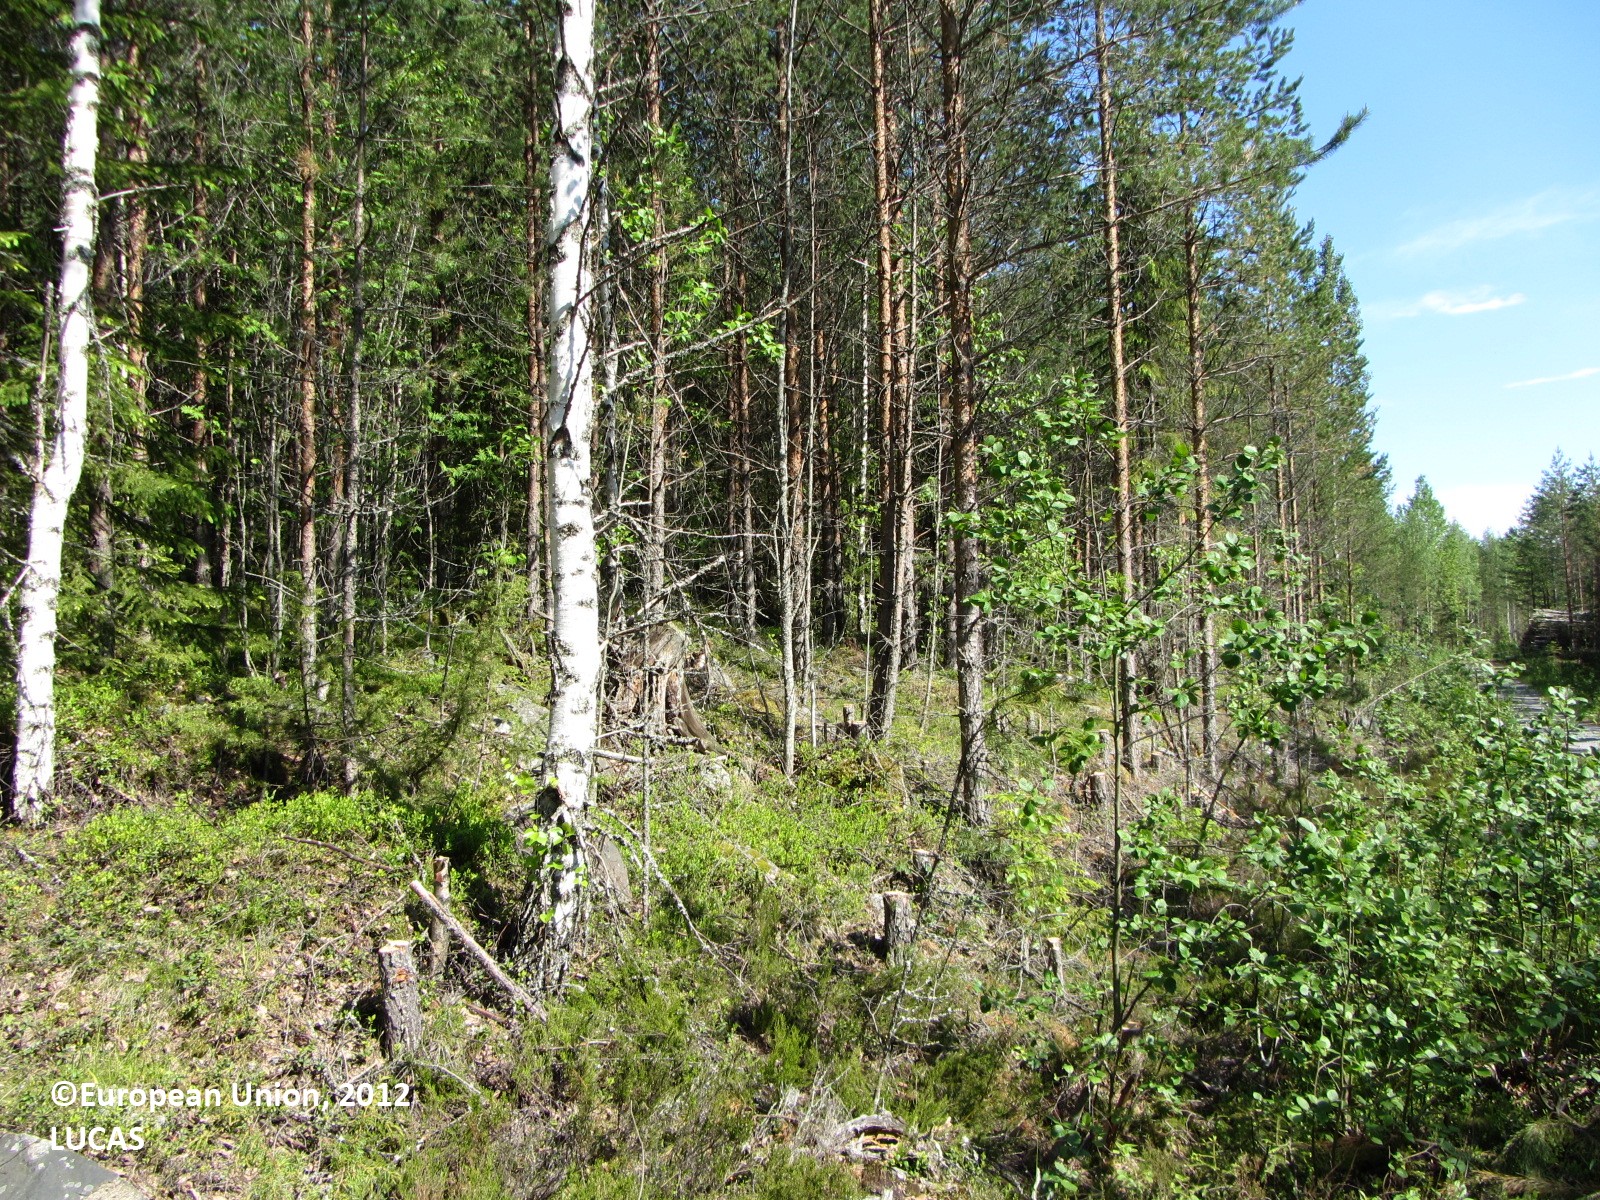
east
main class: Woodland
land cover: Other mixed woodland
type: boreal forest
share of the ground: > 75 %
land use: Forestry
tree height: > 5 m
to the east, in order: Other mixed woodland; Rock outcrops; Other mixed woodland; Pine dominated mixed woodland; Rock outcrops; Pine dominated coniferous woodland; Pine dominated mixed woodland; Spruce dominated mixed woodland; Tracks; Other mixed woodland; Tracks; Pine dominated mixed woodland; Tracks; Pine dominated coniferous woodland; Tracks; Other coniferous woodland; Tracks; Other coniferous woodland
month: June
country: FI
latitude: 62.3112
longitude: 24.8564
